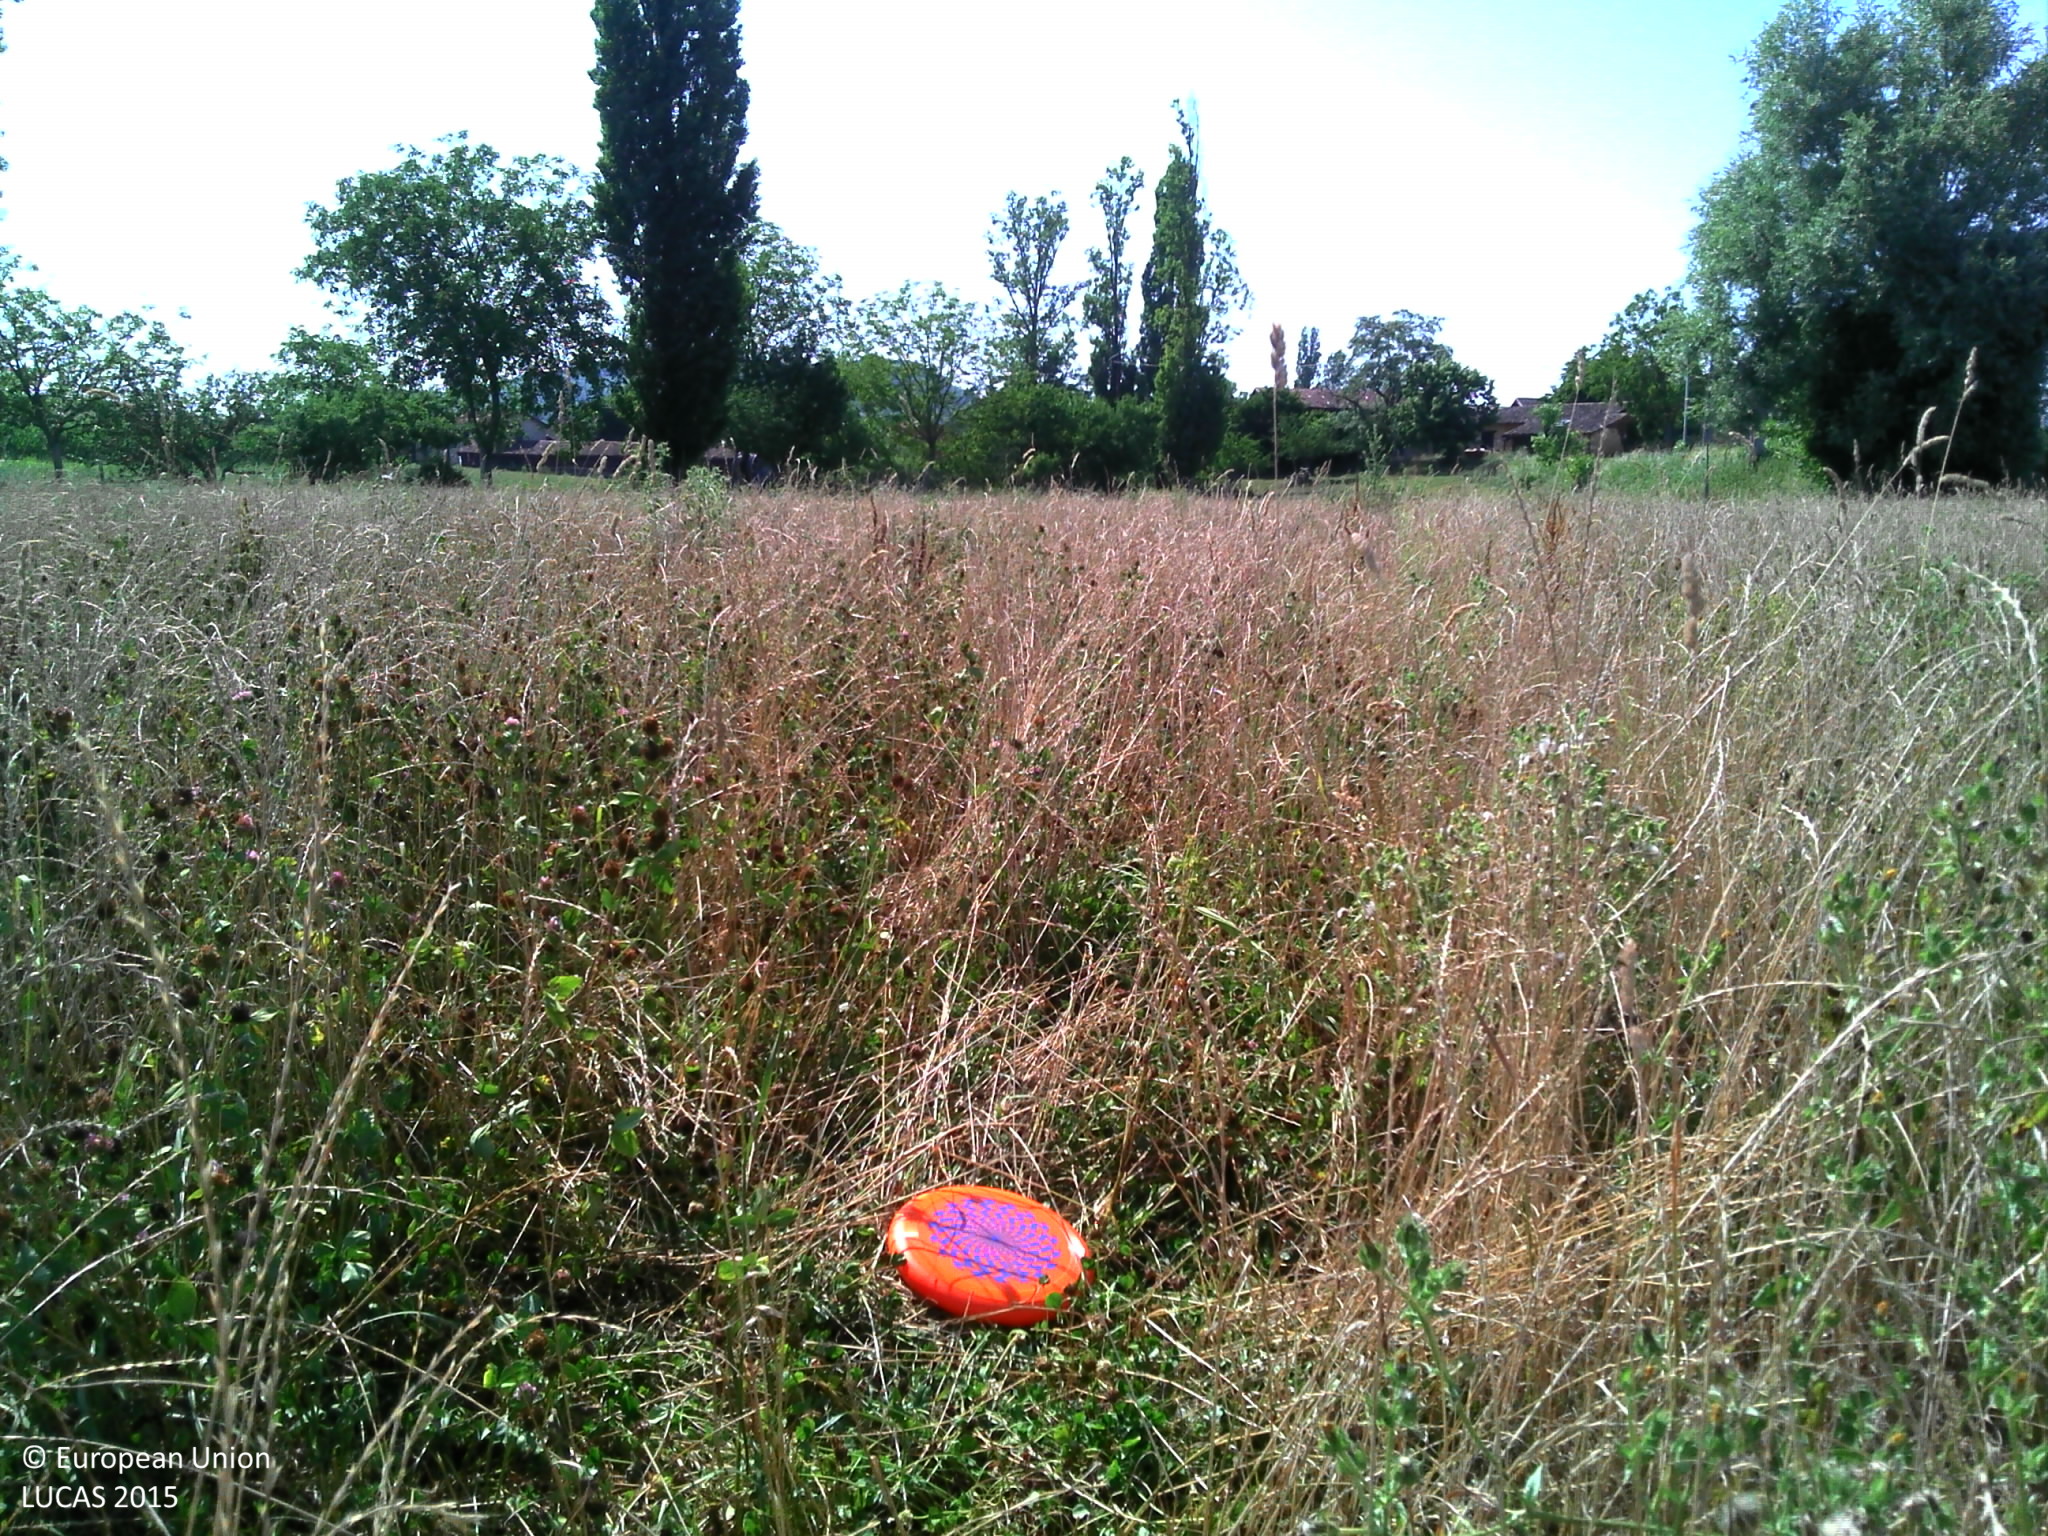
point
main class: Grassland
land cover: Grassland without tree/shrub cover
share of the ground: > 75 %
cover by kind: herbaceous plants 100 %
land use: Agriculture (excluding fallow land and kitchen gardens)
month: July
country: FR
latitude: 44.4386
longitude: 0.8863
